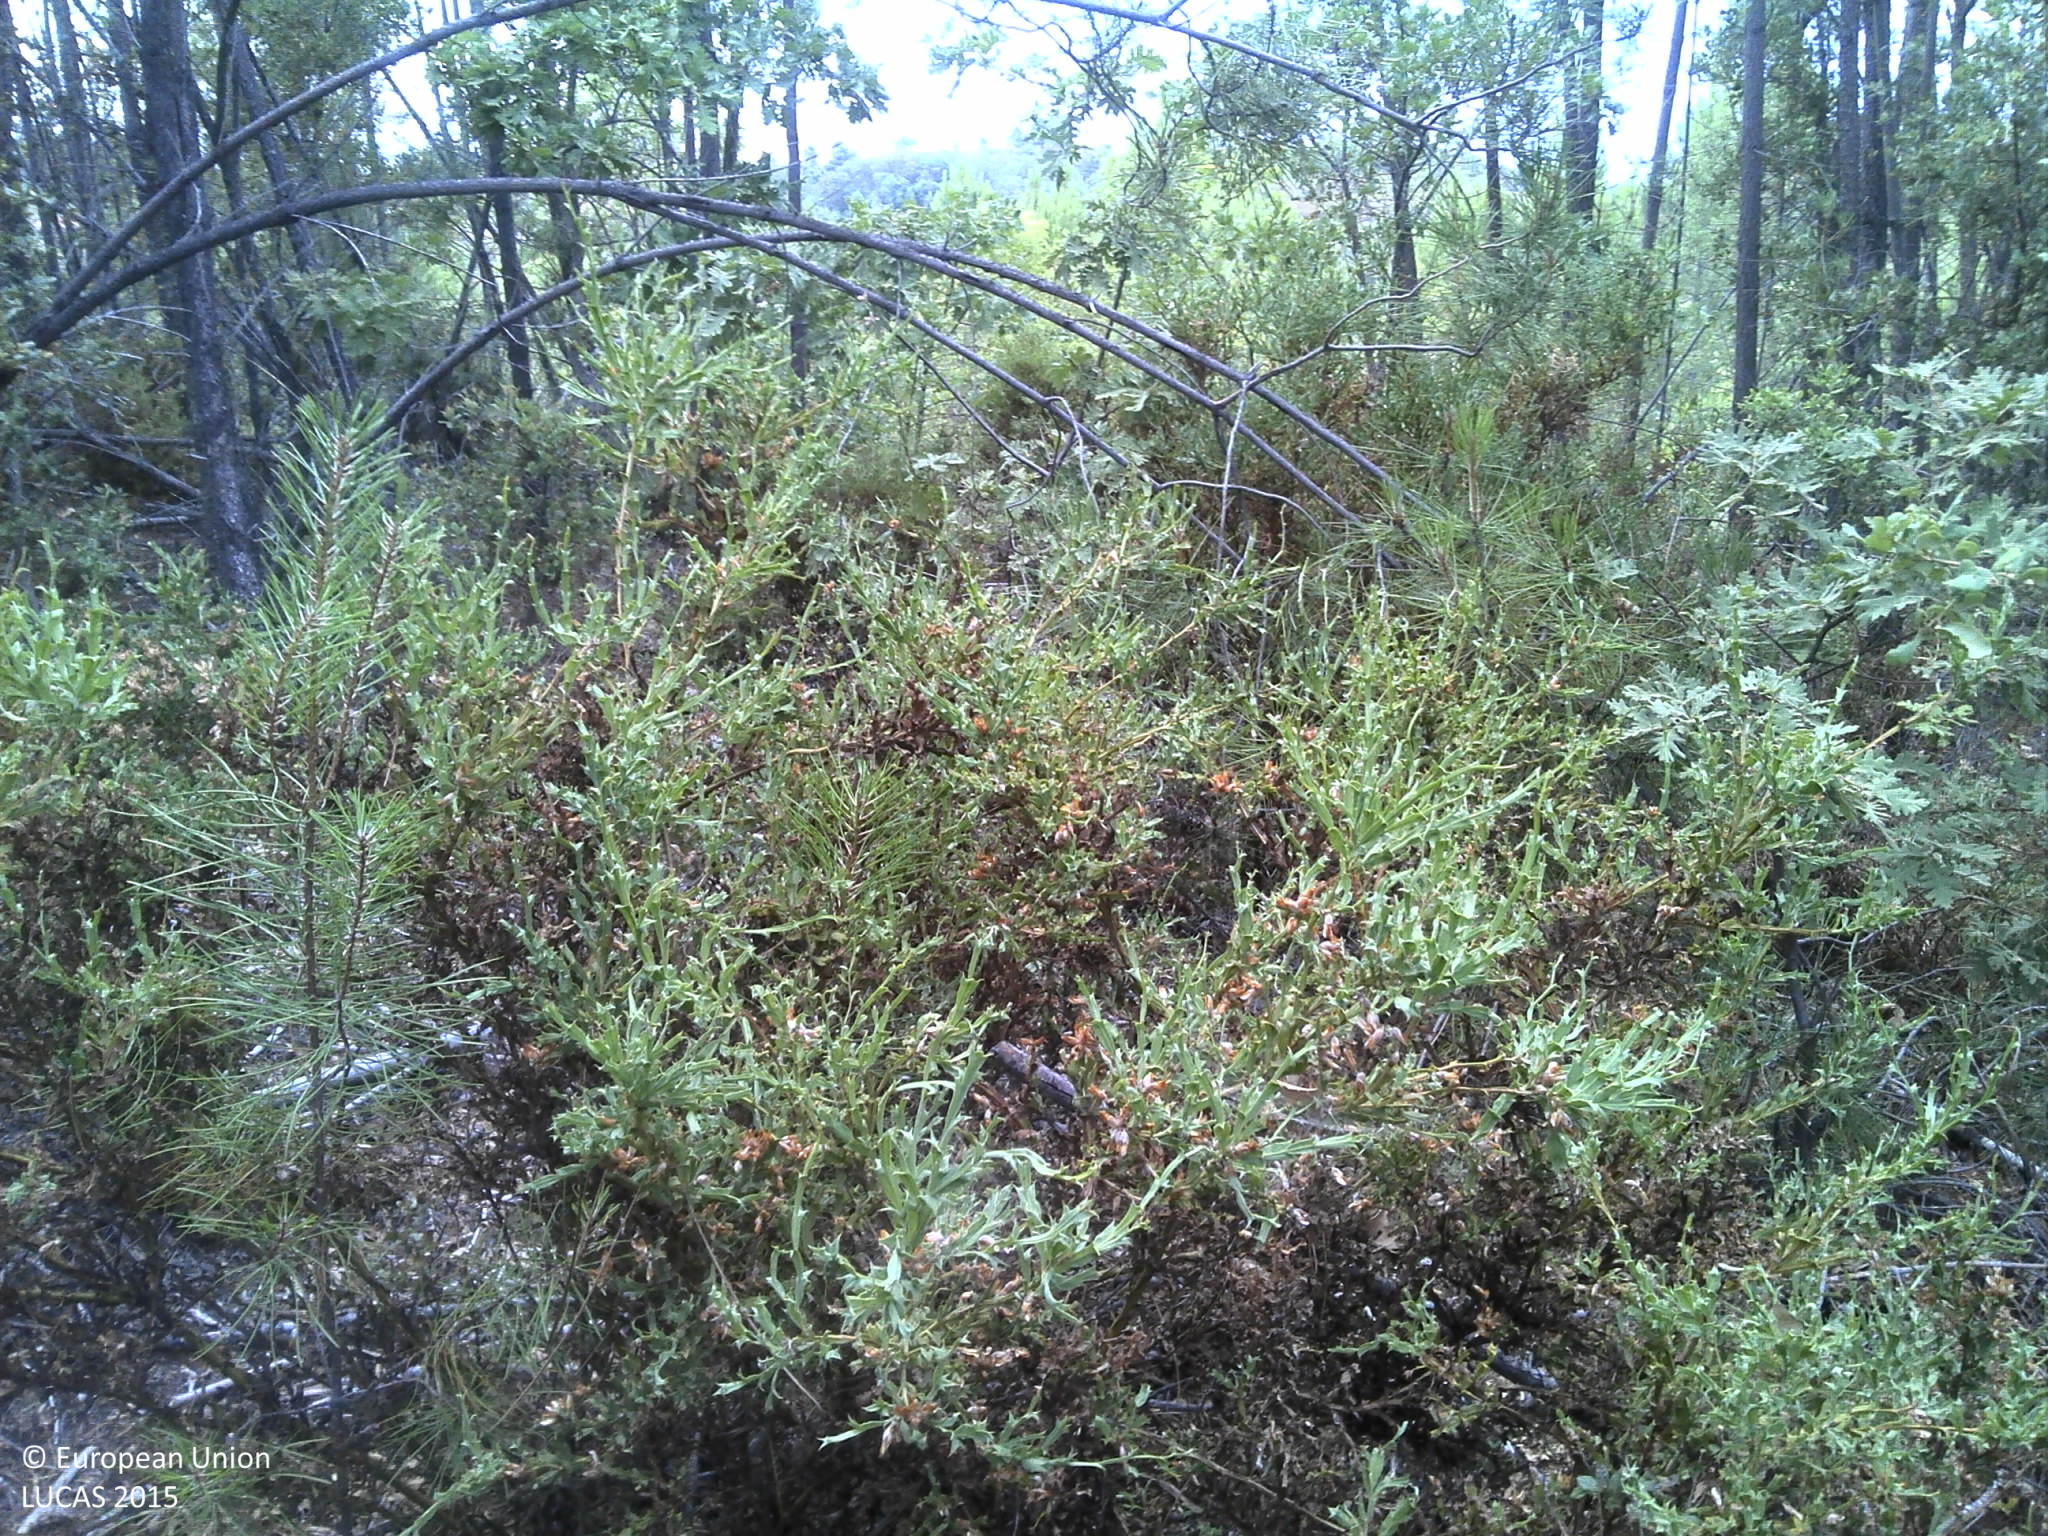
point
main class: Woodland
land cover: Pine dominated coniferous woodland
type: coniferous forest of the mediterranean region
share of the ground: 50 - 75 %
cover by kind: coniferous forest trees 55 %, shrubs 35 %, unconsolidated bare surface 10 %
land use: Forestry
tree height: > 5 m
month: June
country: PT
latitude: 40.2484
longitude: -7.3008
